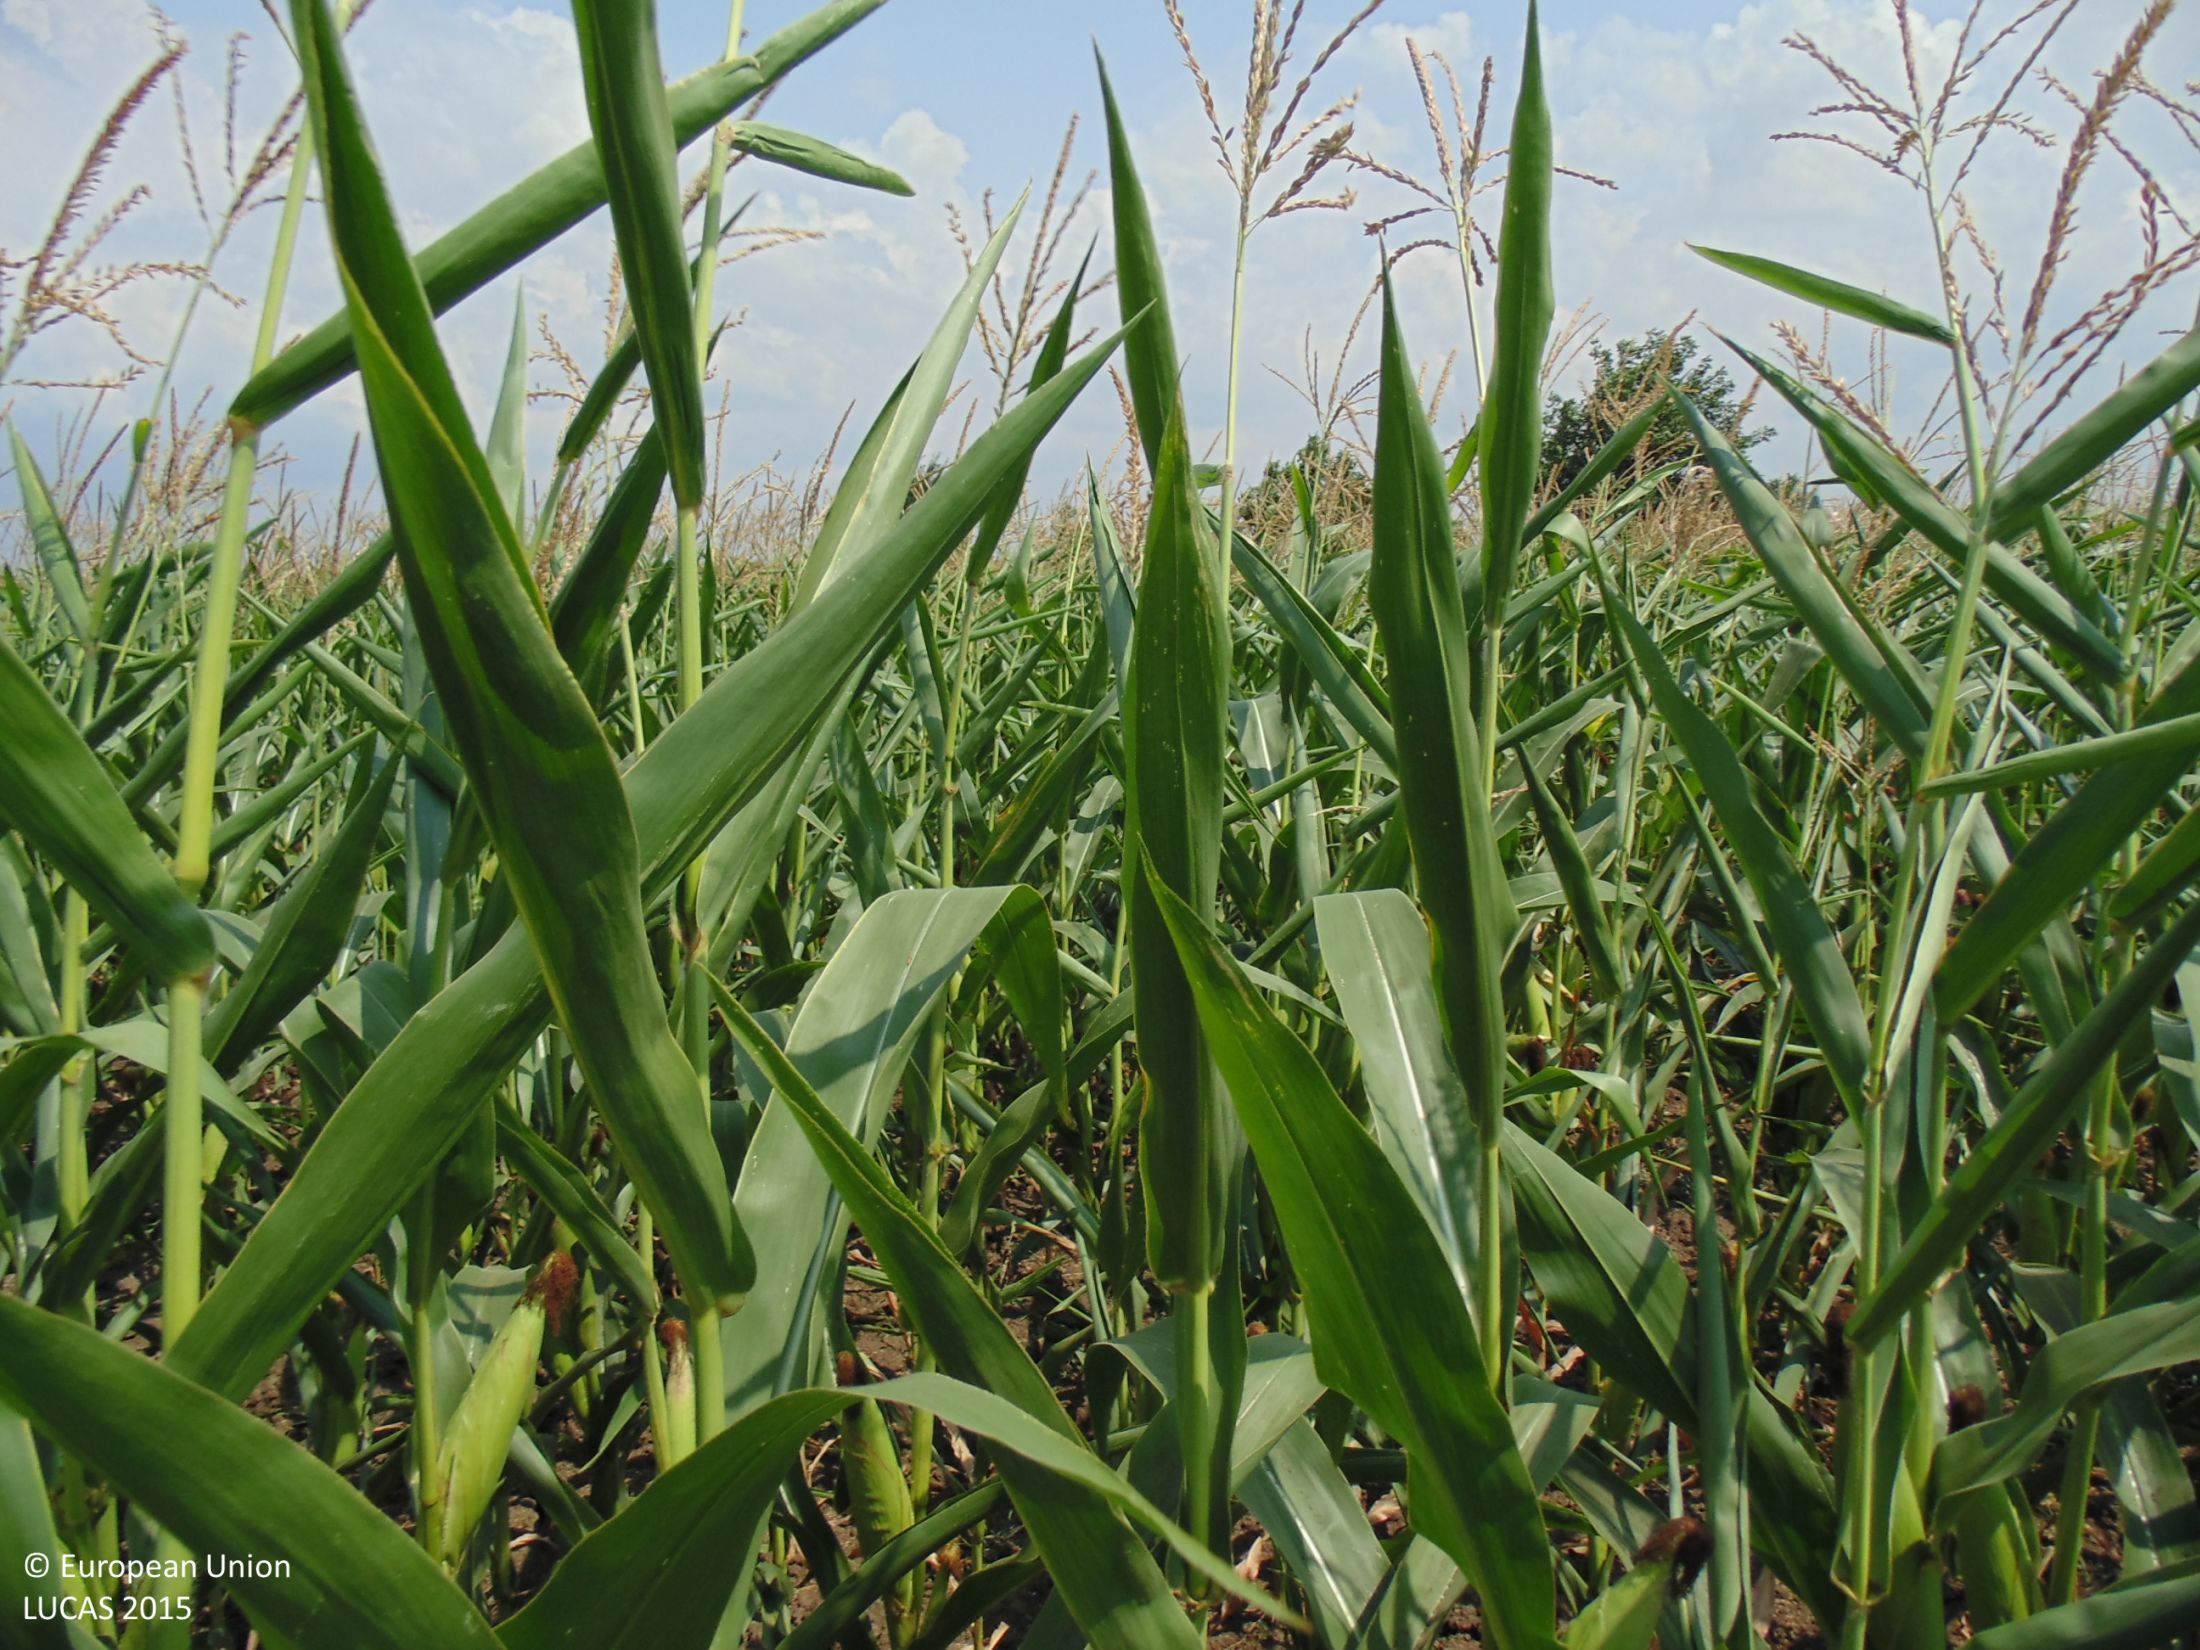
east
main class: Cropland
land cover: Maize
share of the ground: > 75 %
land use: Agriculture (excluding fallow land and kitchen gardens)
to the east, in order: Maize; Grass margins; Single bushes/trees; Grass margins; Sunflower; Electric lines; Sunflower; Common wheat
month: July
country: BG
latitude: 43.6787
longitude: 28.0229
